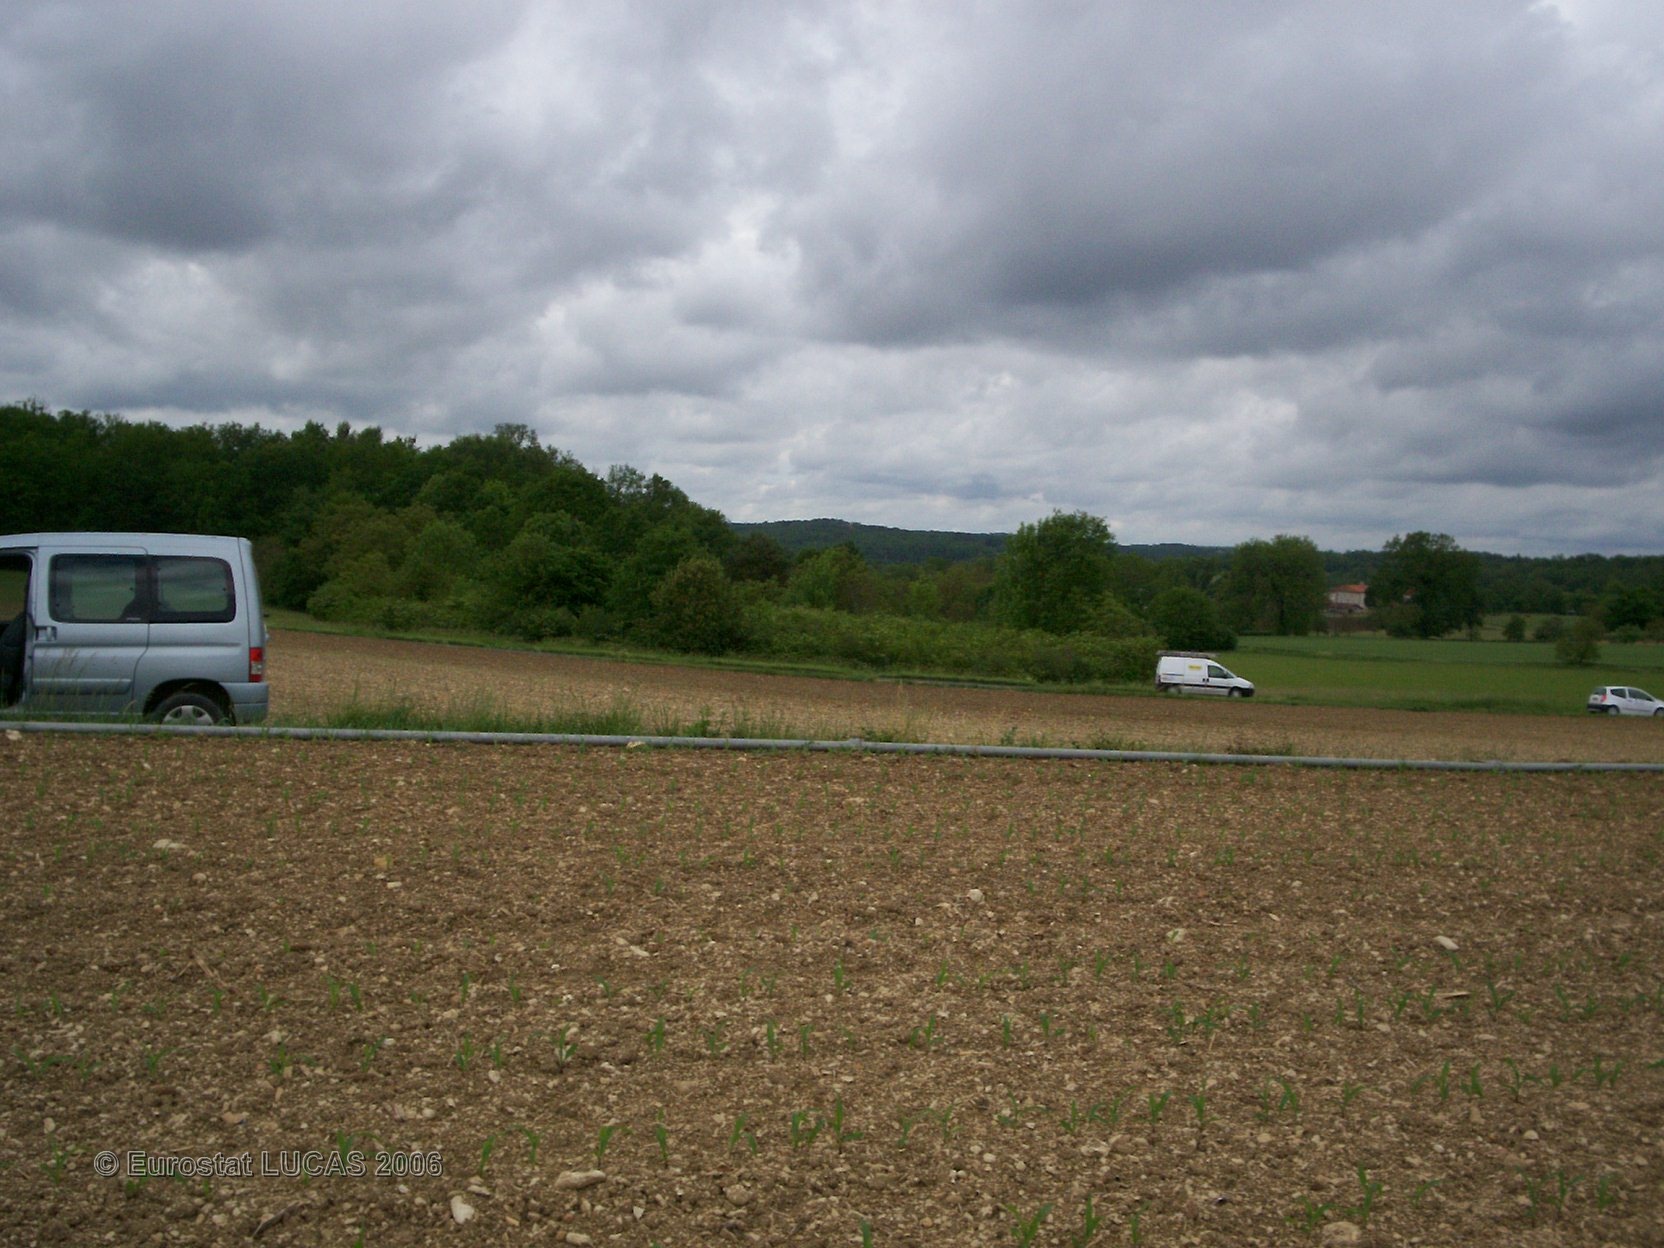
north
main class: Cropland
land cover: Maize
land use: Agriculture (excluding fallow land and kitchen gardens)
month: May
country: FR
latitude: 45.2986
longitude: 0.5645
